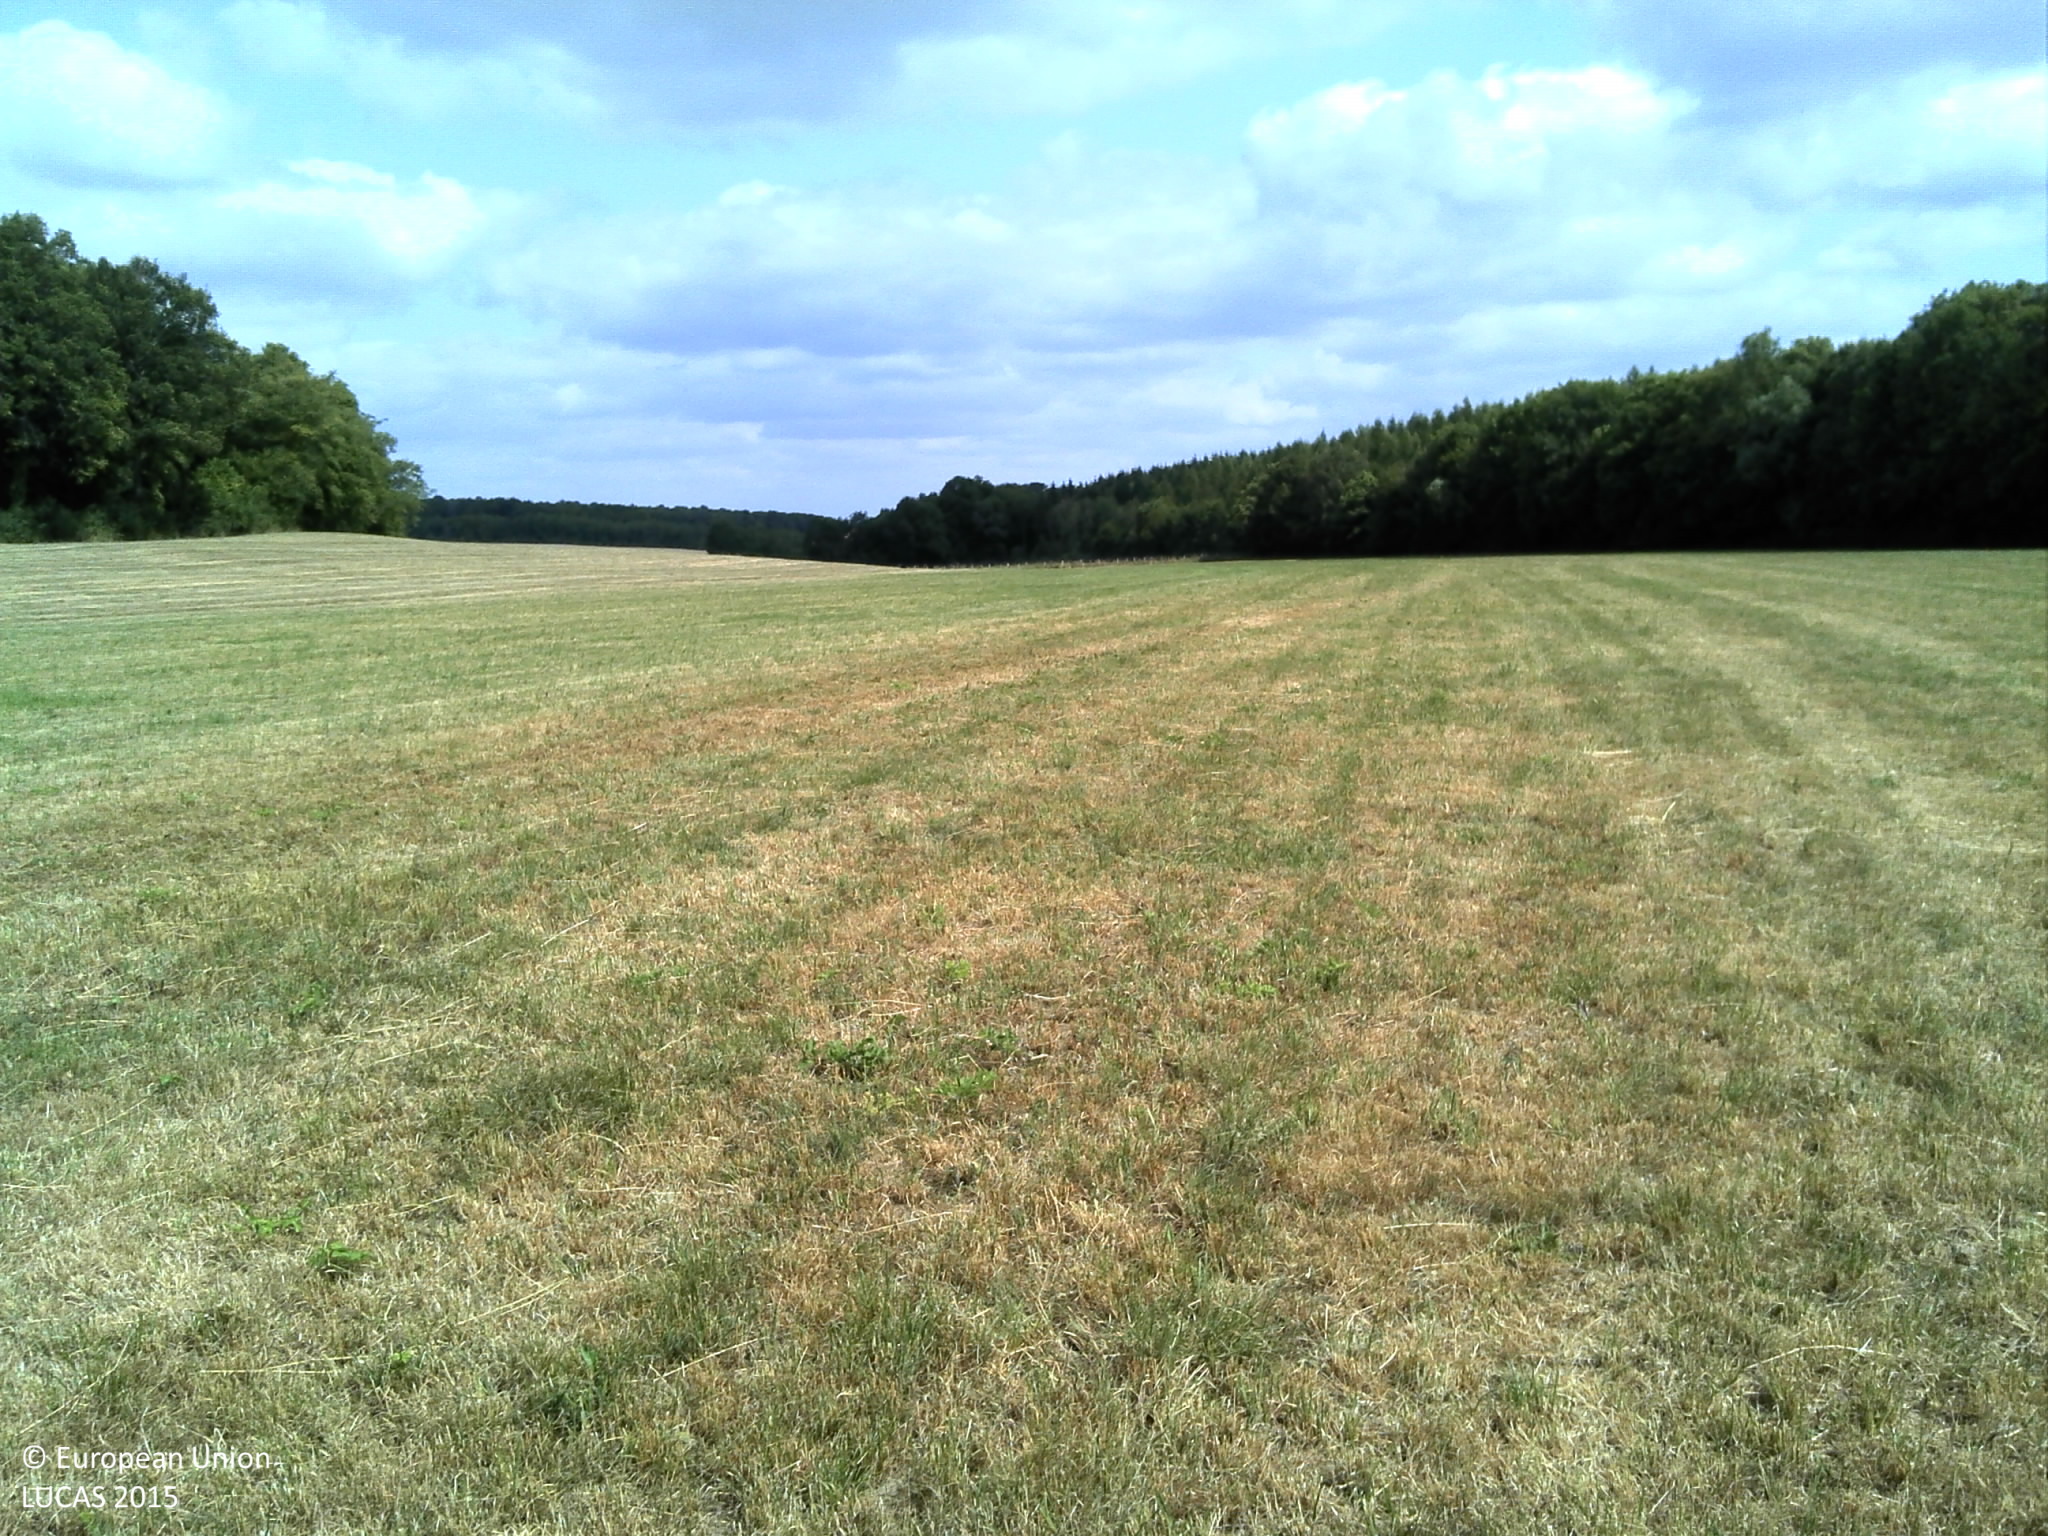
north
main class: Grassland
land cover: Grassland without tree/shrub cover
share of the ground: > 75 %
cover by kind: herbaceous plants 100 %
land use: Agriculture (excluding fallow land and kitchen gardens)
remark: Harvested field
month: July
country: FR
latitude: 48.1778
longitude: 6.2484
